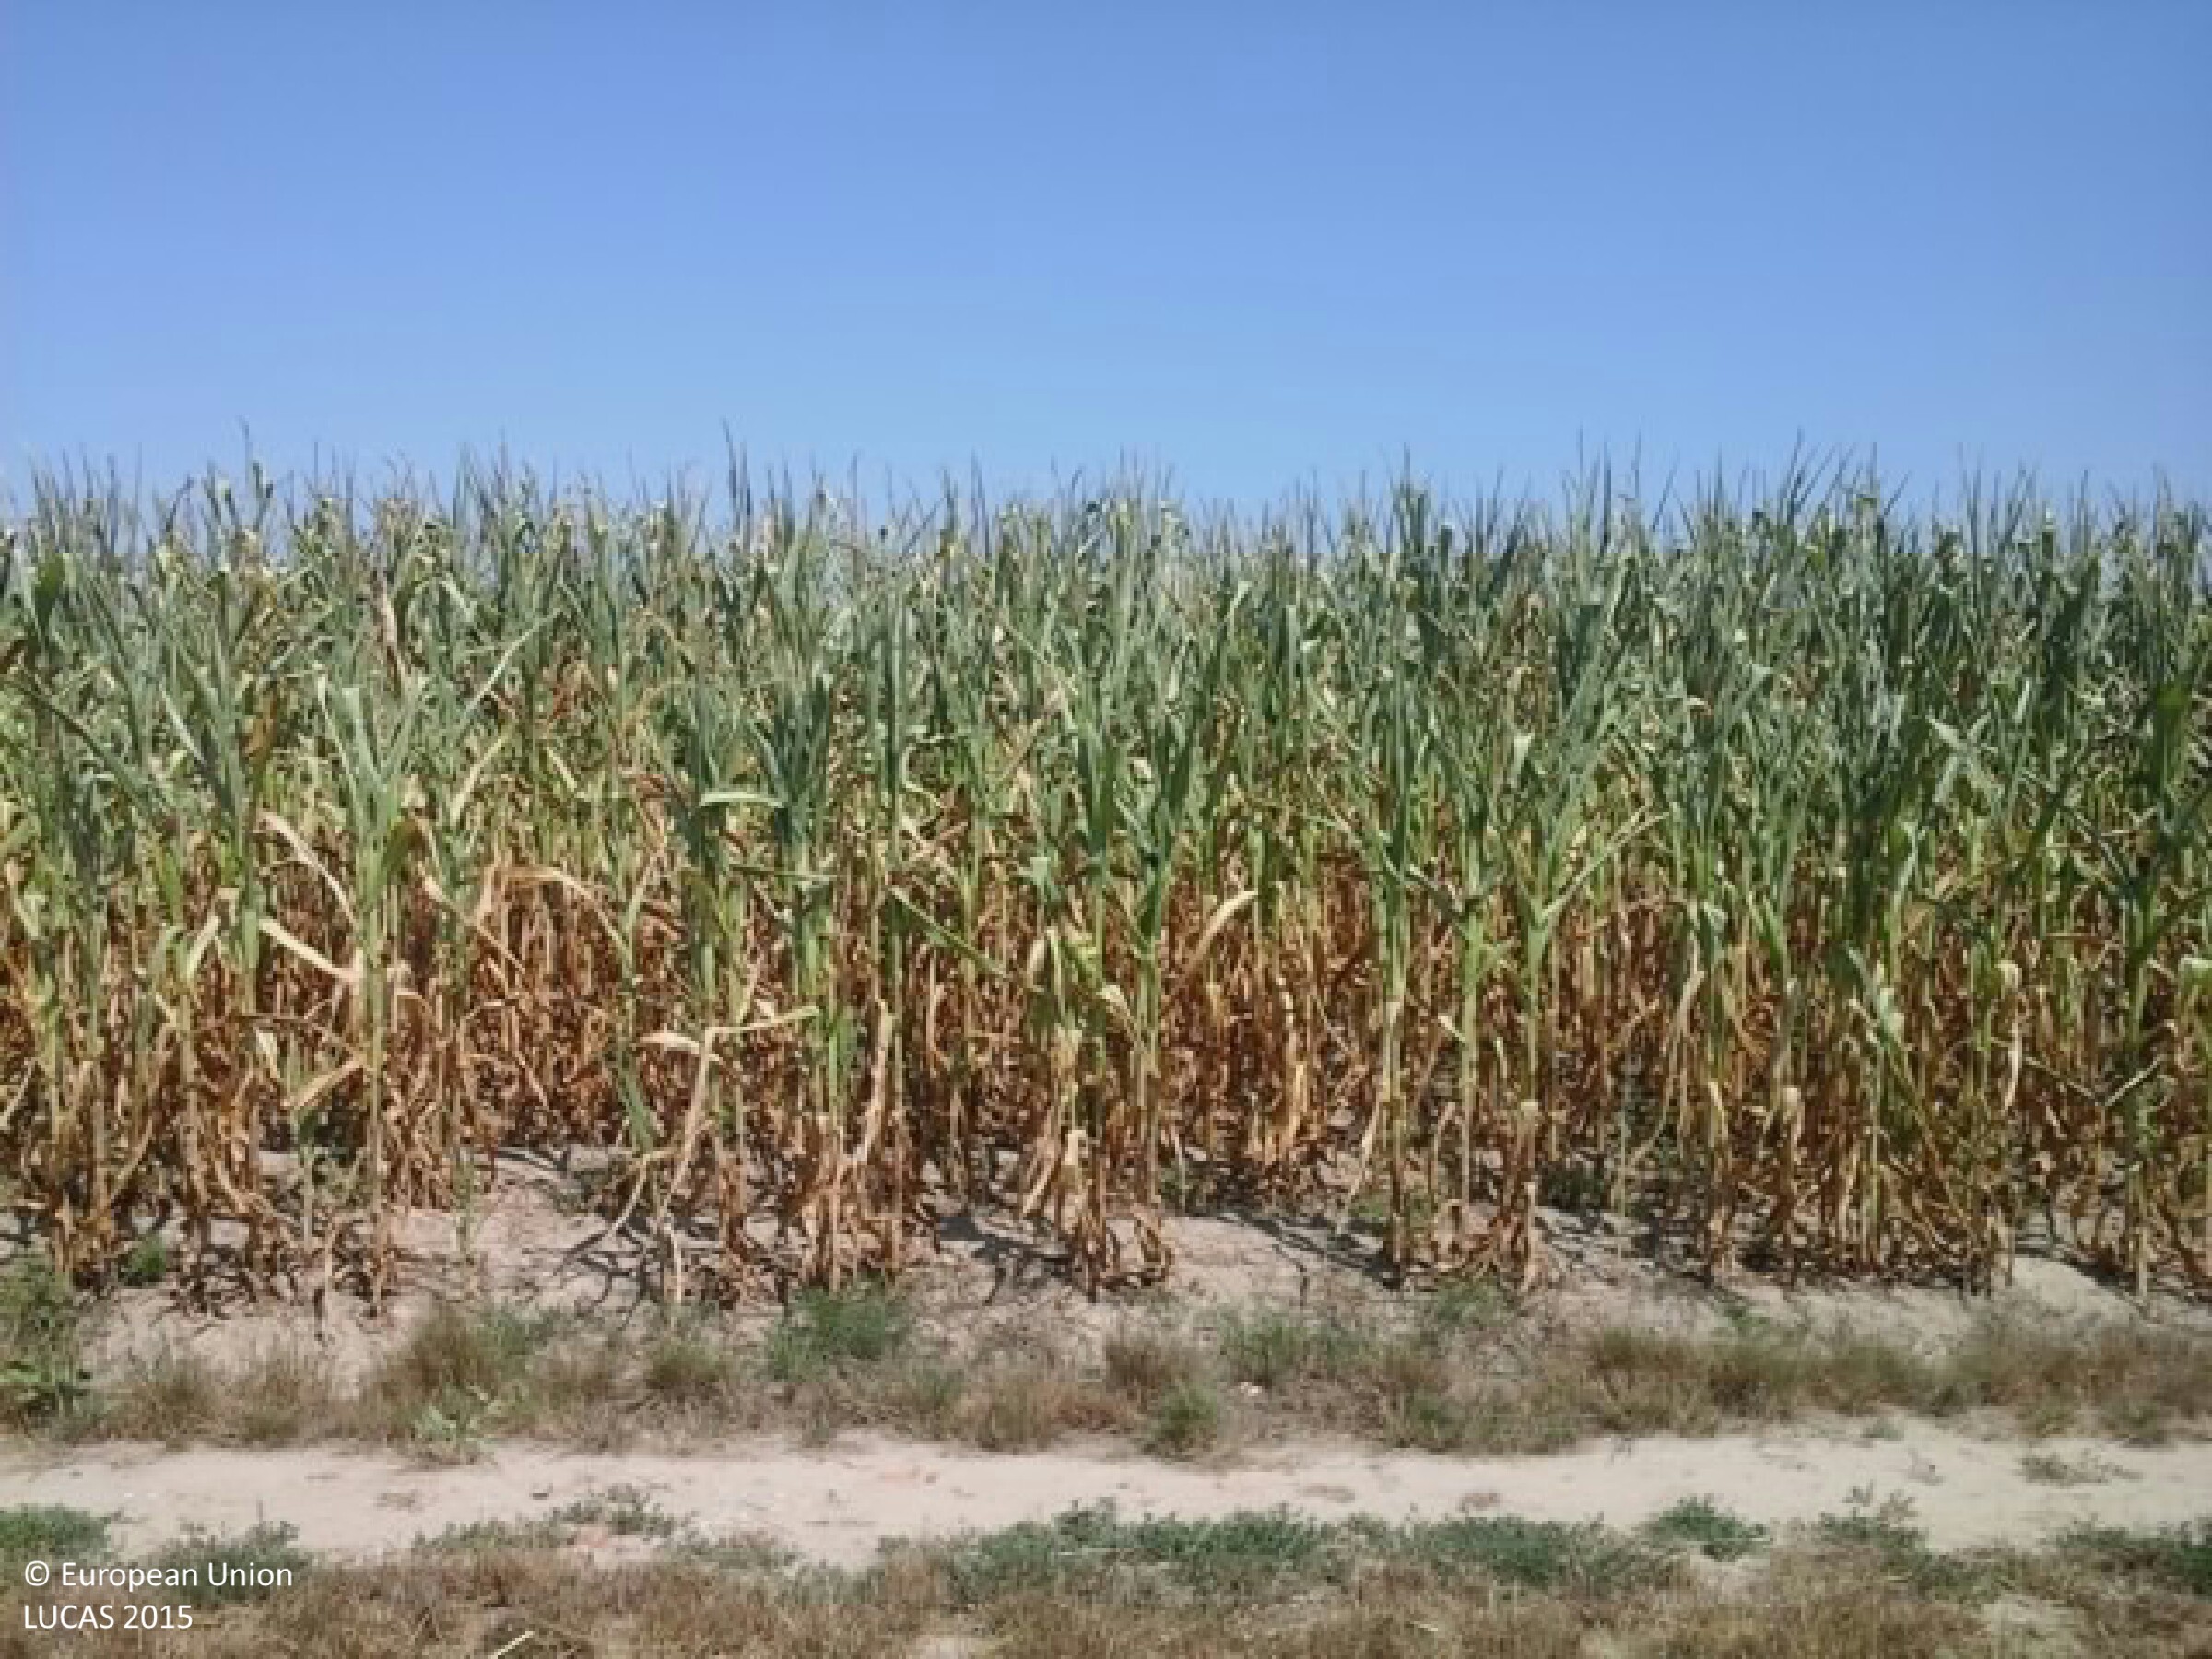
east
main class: Cropland
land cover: Common wheat
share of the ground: < 10 %
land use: Agriculture (excluding fallow land and kitchen gardens)
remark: Harvested field
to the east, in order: Common wheat; Electric lines; Tracks; Electric lines; Maize
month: July
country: HU
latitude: 46.2581
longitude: 17.1247
